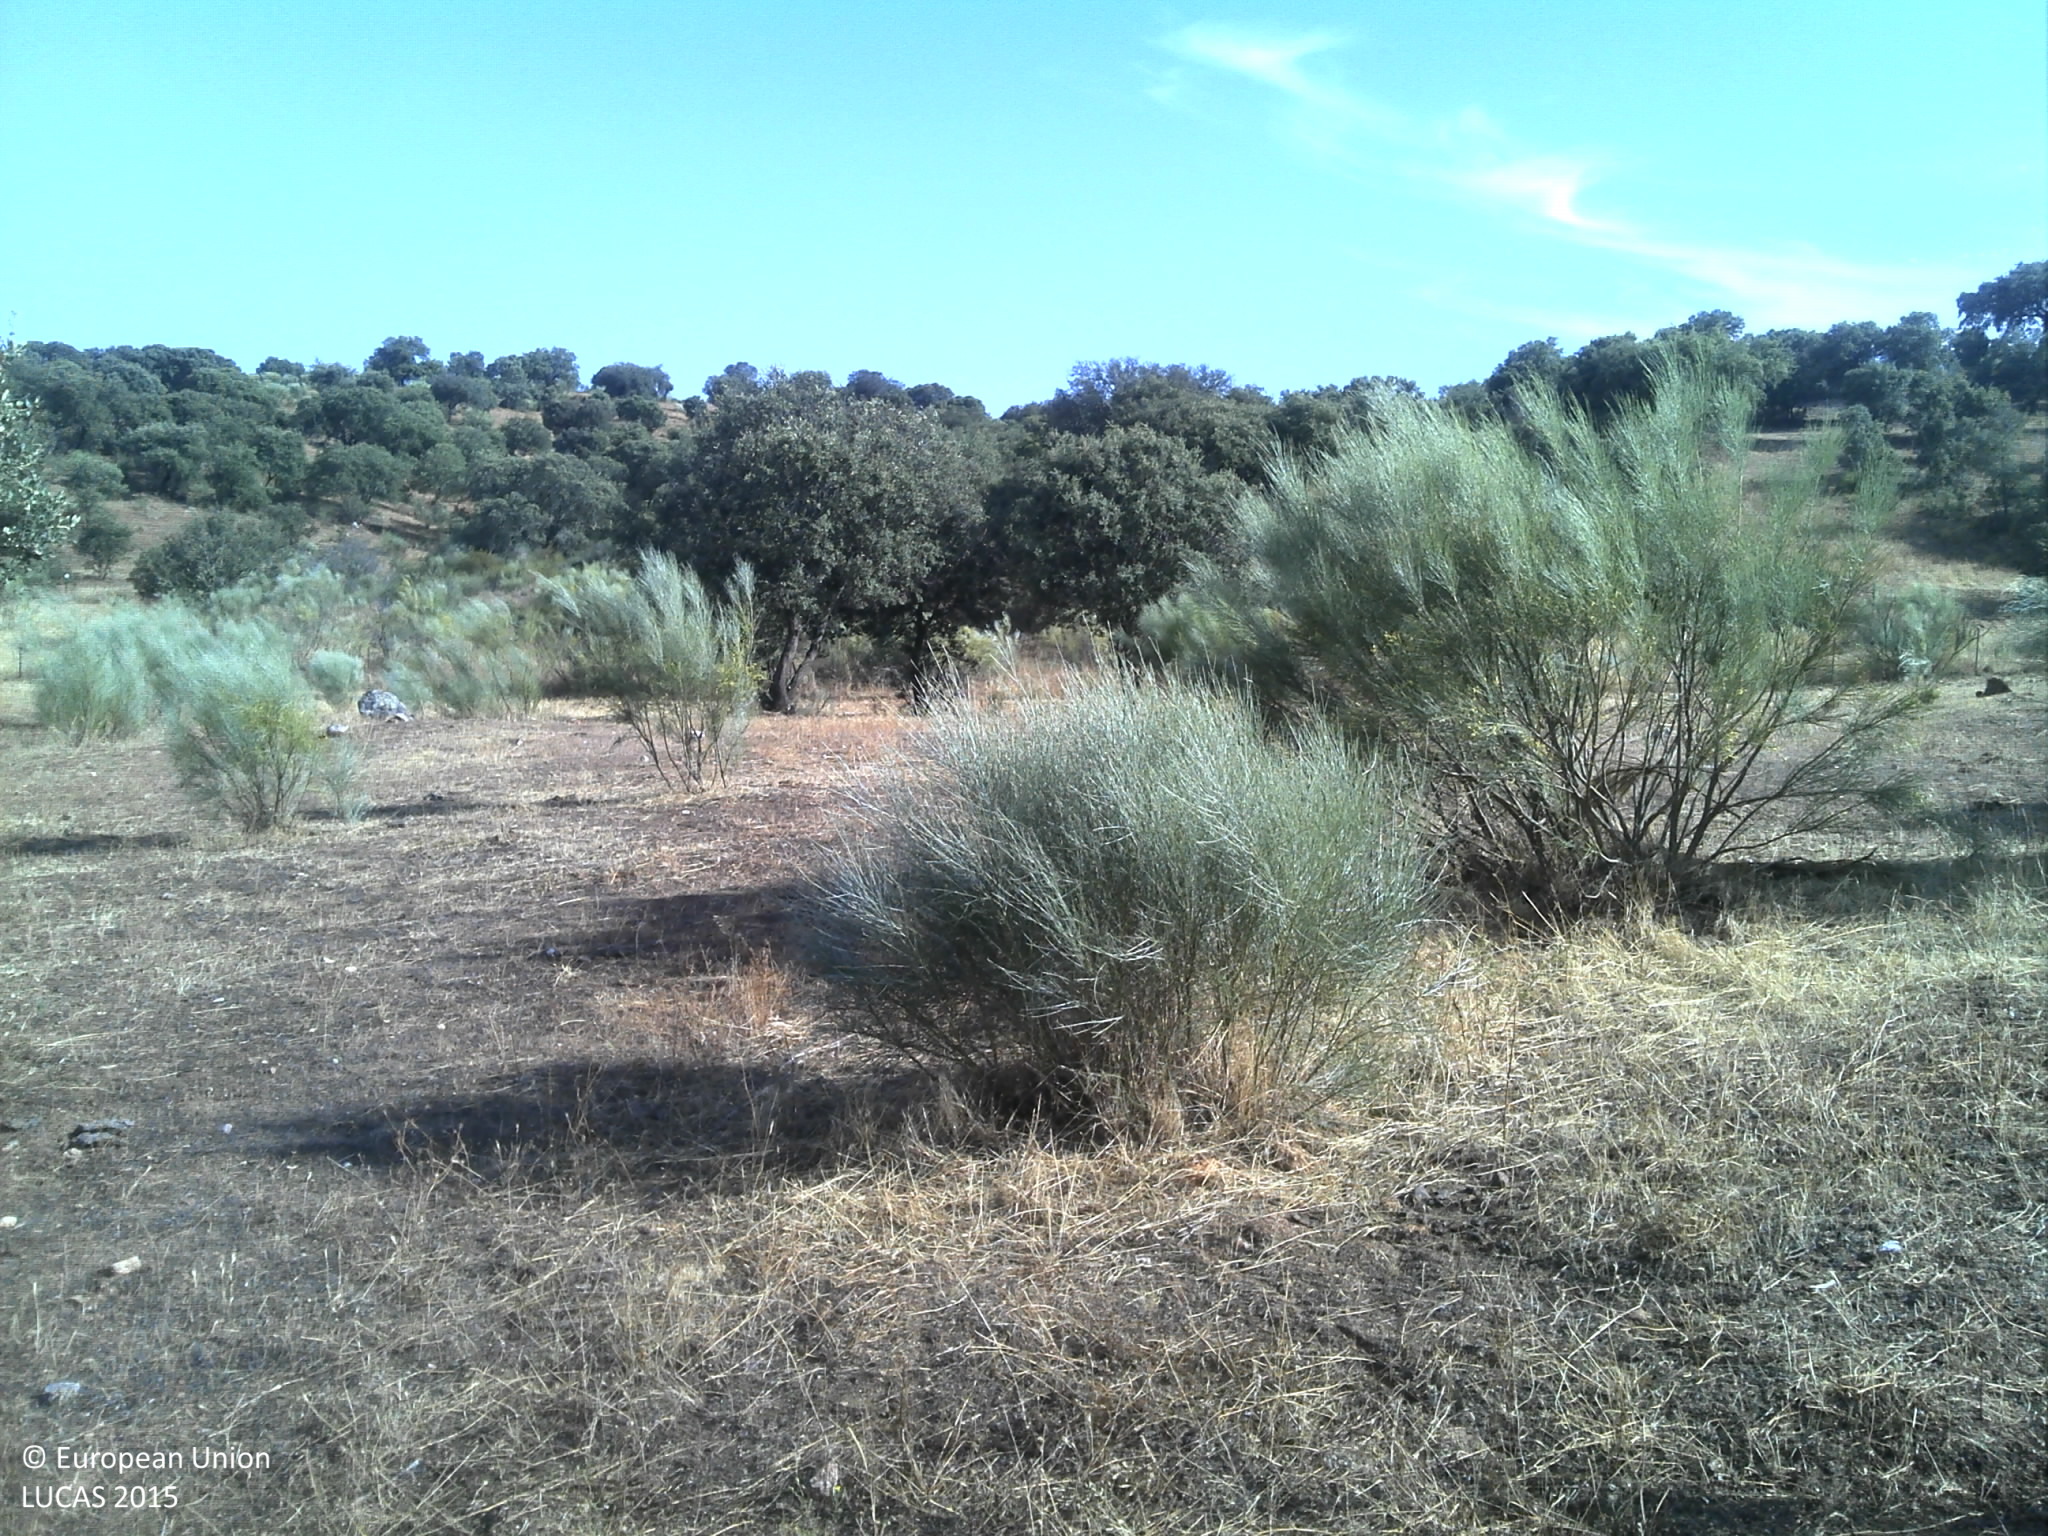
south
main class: Woodland
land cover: Broadleaved woodland
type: broadleaved evergreen forest
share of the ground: 10 - 25 %
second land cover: Grassland without tree/shrub cover
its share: 25 - 50 %
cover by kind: unconsolidated bare surface 45 %, herbaceous plants 30 %, broadleaved forest trees 15 %, shrubs 10 %
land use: Forestry
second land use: Agriculture (excluding fallow land and kitchen gardens)
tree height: > 5 m
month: June
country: PT
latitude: 39.8670
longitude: -6.9568
